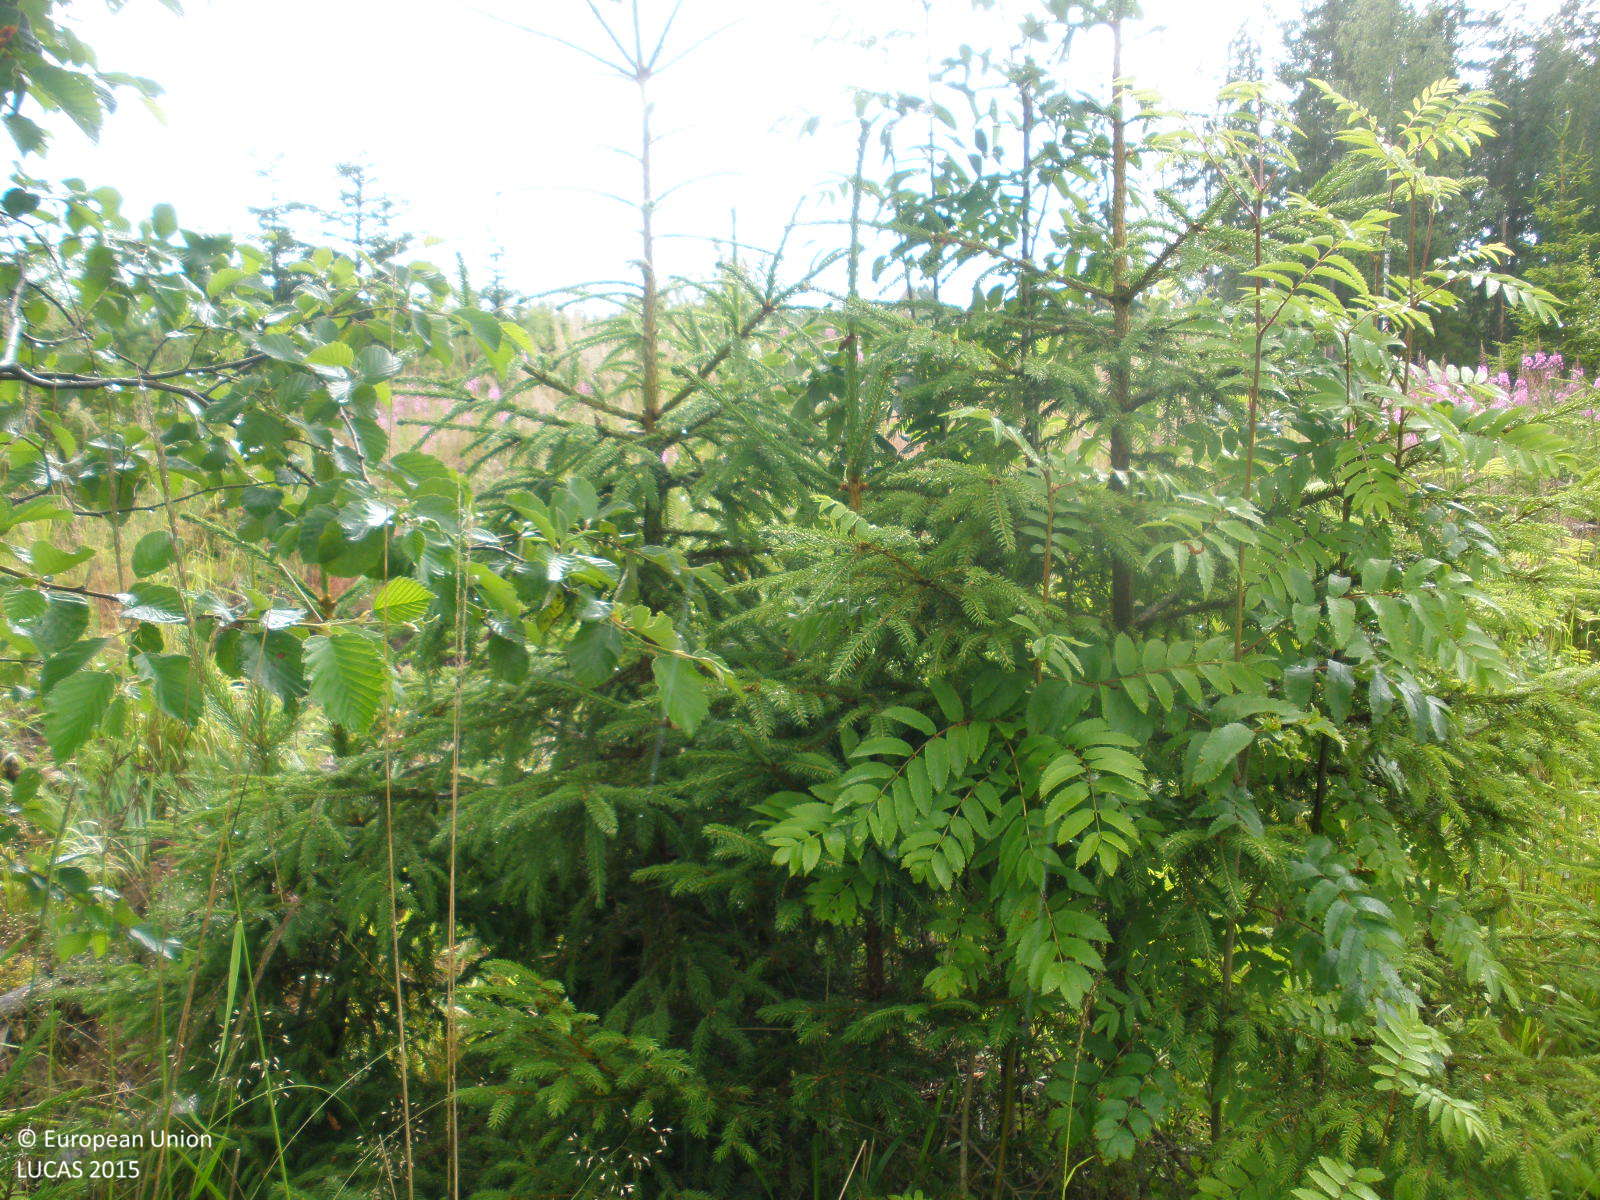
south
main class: Woodland
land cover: Other mixed woodland
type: boreal forest
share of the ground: 10 - 25 %
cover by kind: herbaceous plants 60 %, lichens and mosses 15 %, shrubs 10 %, coniferous forest trees 5 %, broadleaved forest trees 5 %, unconsolidated bare surface 5 %
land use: Forestry
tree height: < 5 m
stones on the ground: > 50 %
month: July
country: FI
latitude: 61.4564
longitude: 24.7563
